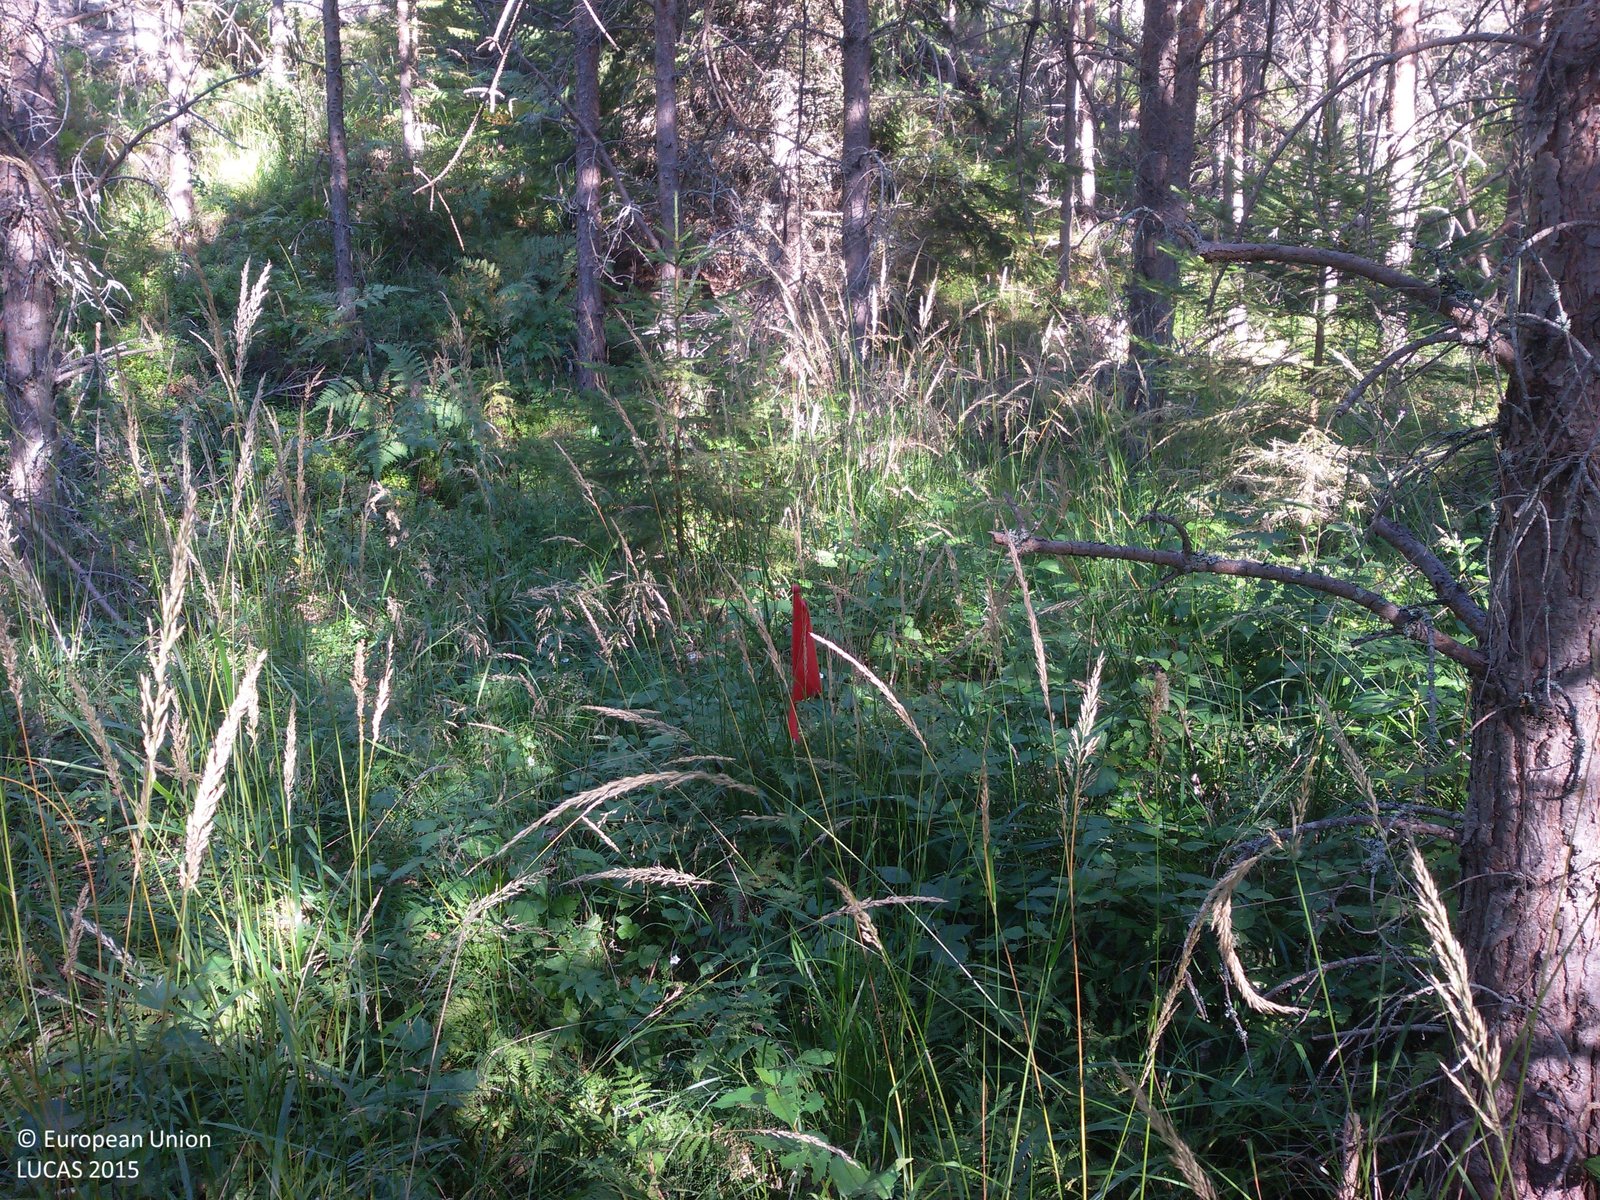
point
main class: Woodland
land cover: Pine dominated coniferous woodland
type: boreal forest
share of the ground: > 75 %
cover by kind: coniferous forest trees 80 %, shrubs 10 %, herbaceous plants 10 %
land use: Forestry
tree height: > 5 m
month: August
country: SE
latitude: 60.6534
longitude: 15.8956
